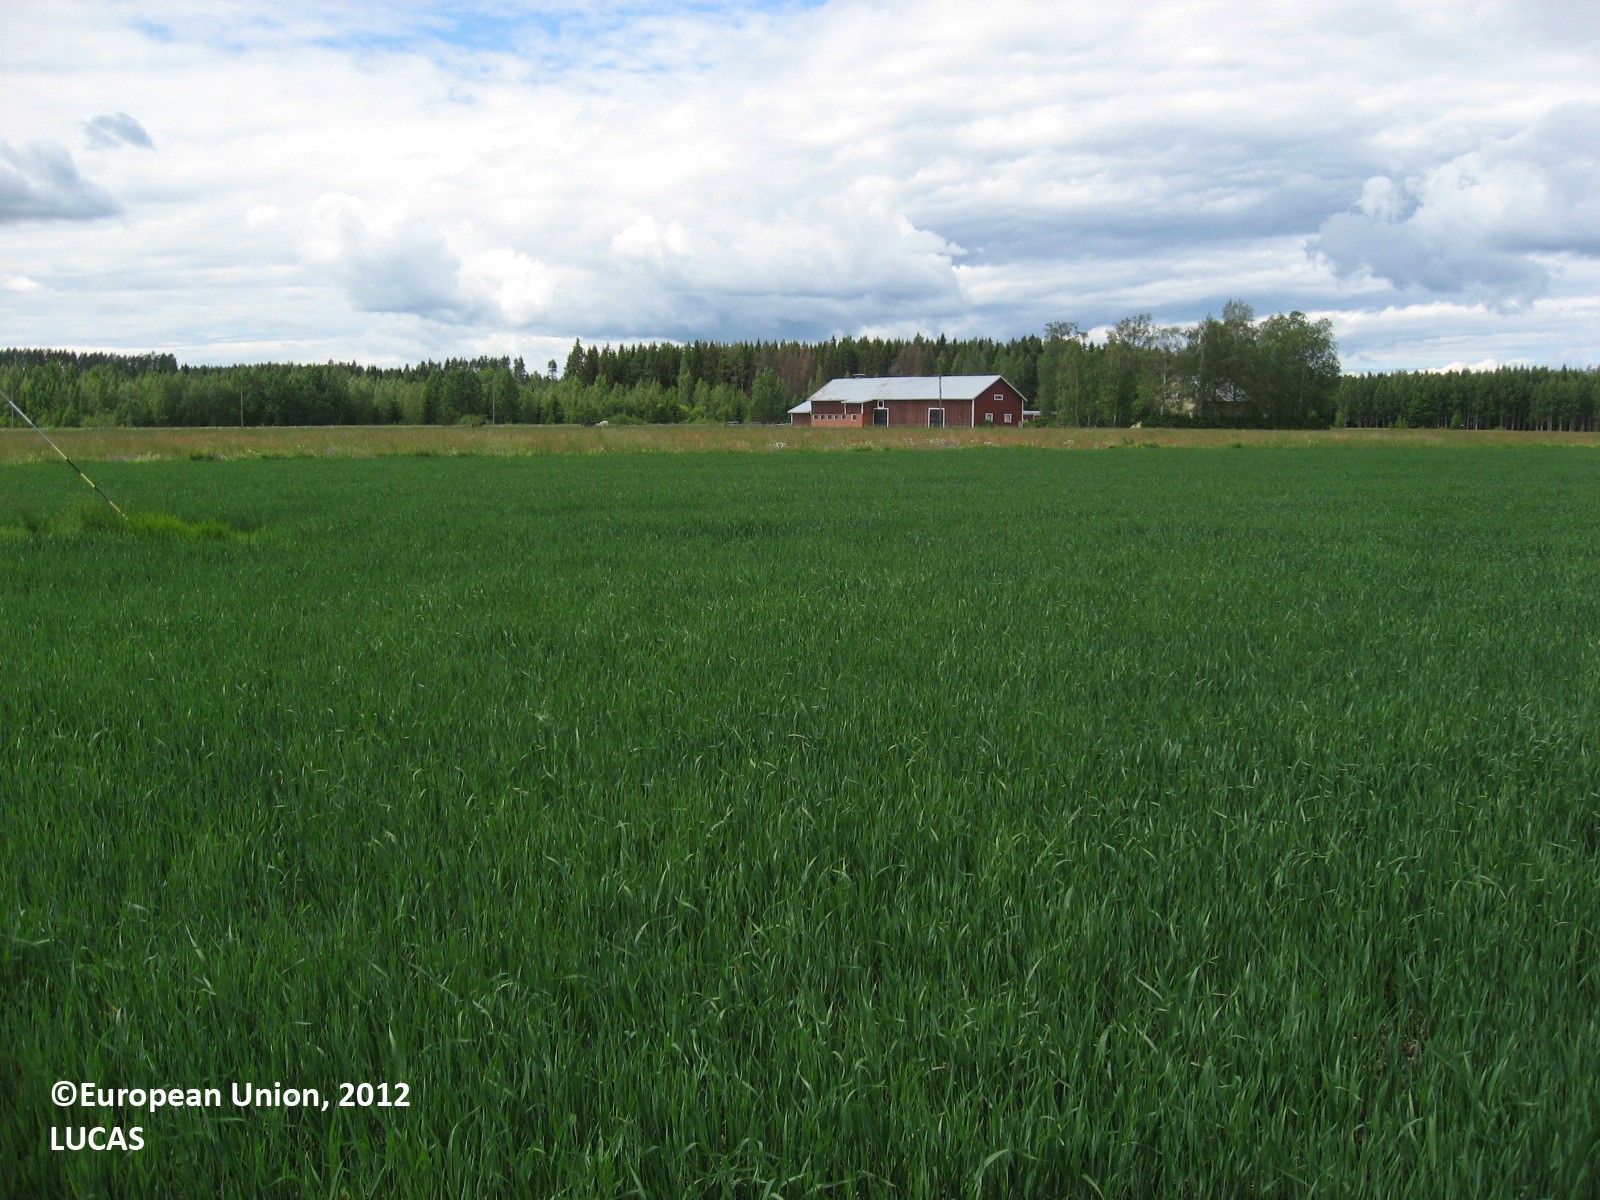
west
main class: Cropland
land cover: Oats
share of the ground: > 75 %
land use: Agriculture (excluding fallow land and kitchen gardens)
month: June
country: FI
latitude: 60.7623
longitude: 26.5452
